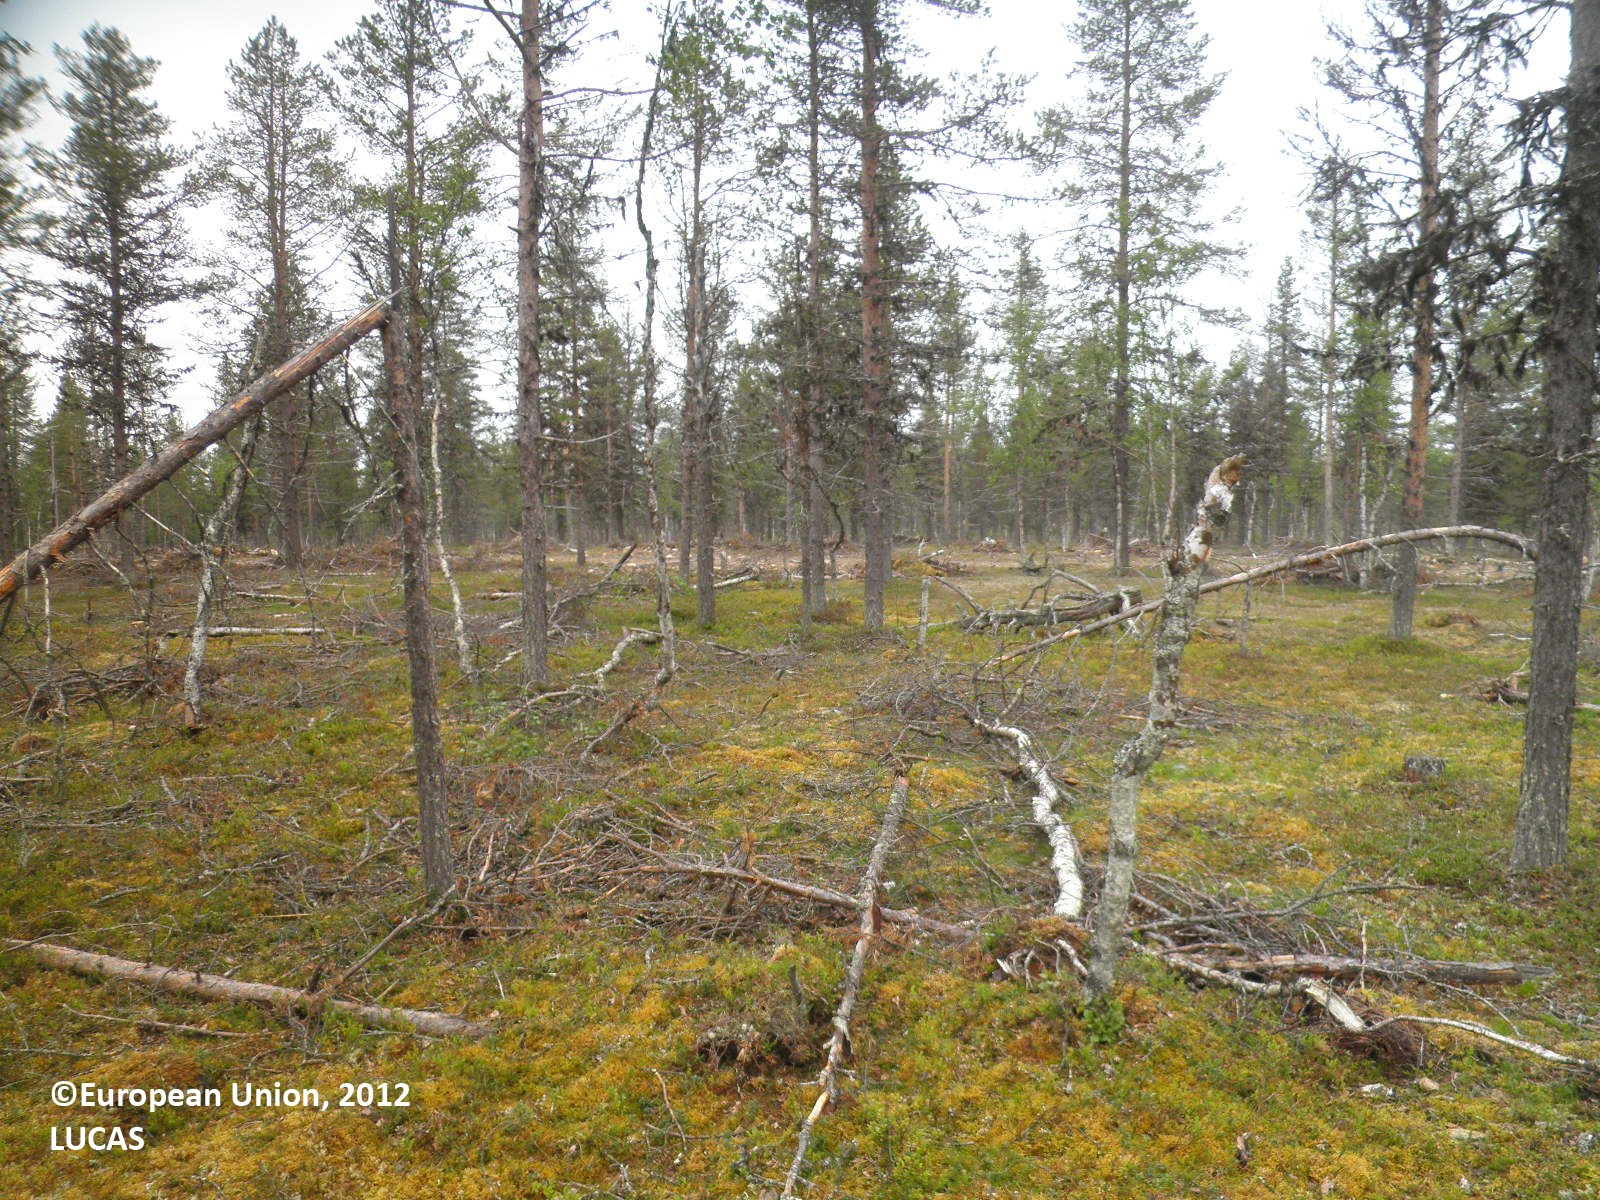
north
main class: Woodland
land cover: Pine dominated coniferous woodland
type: boreal forest
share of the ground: 25 - 50 %
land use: Forestry
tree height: > 5 m
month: July
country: FI
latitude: 68.2420
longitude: 25.5332
